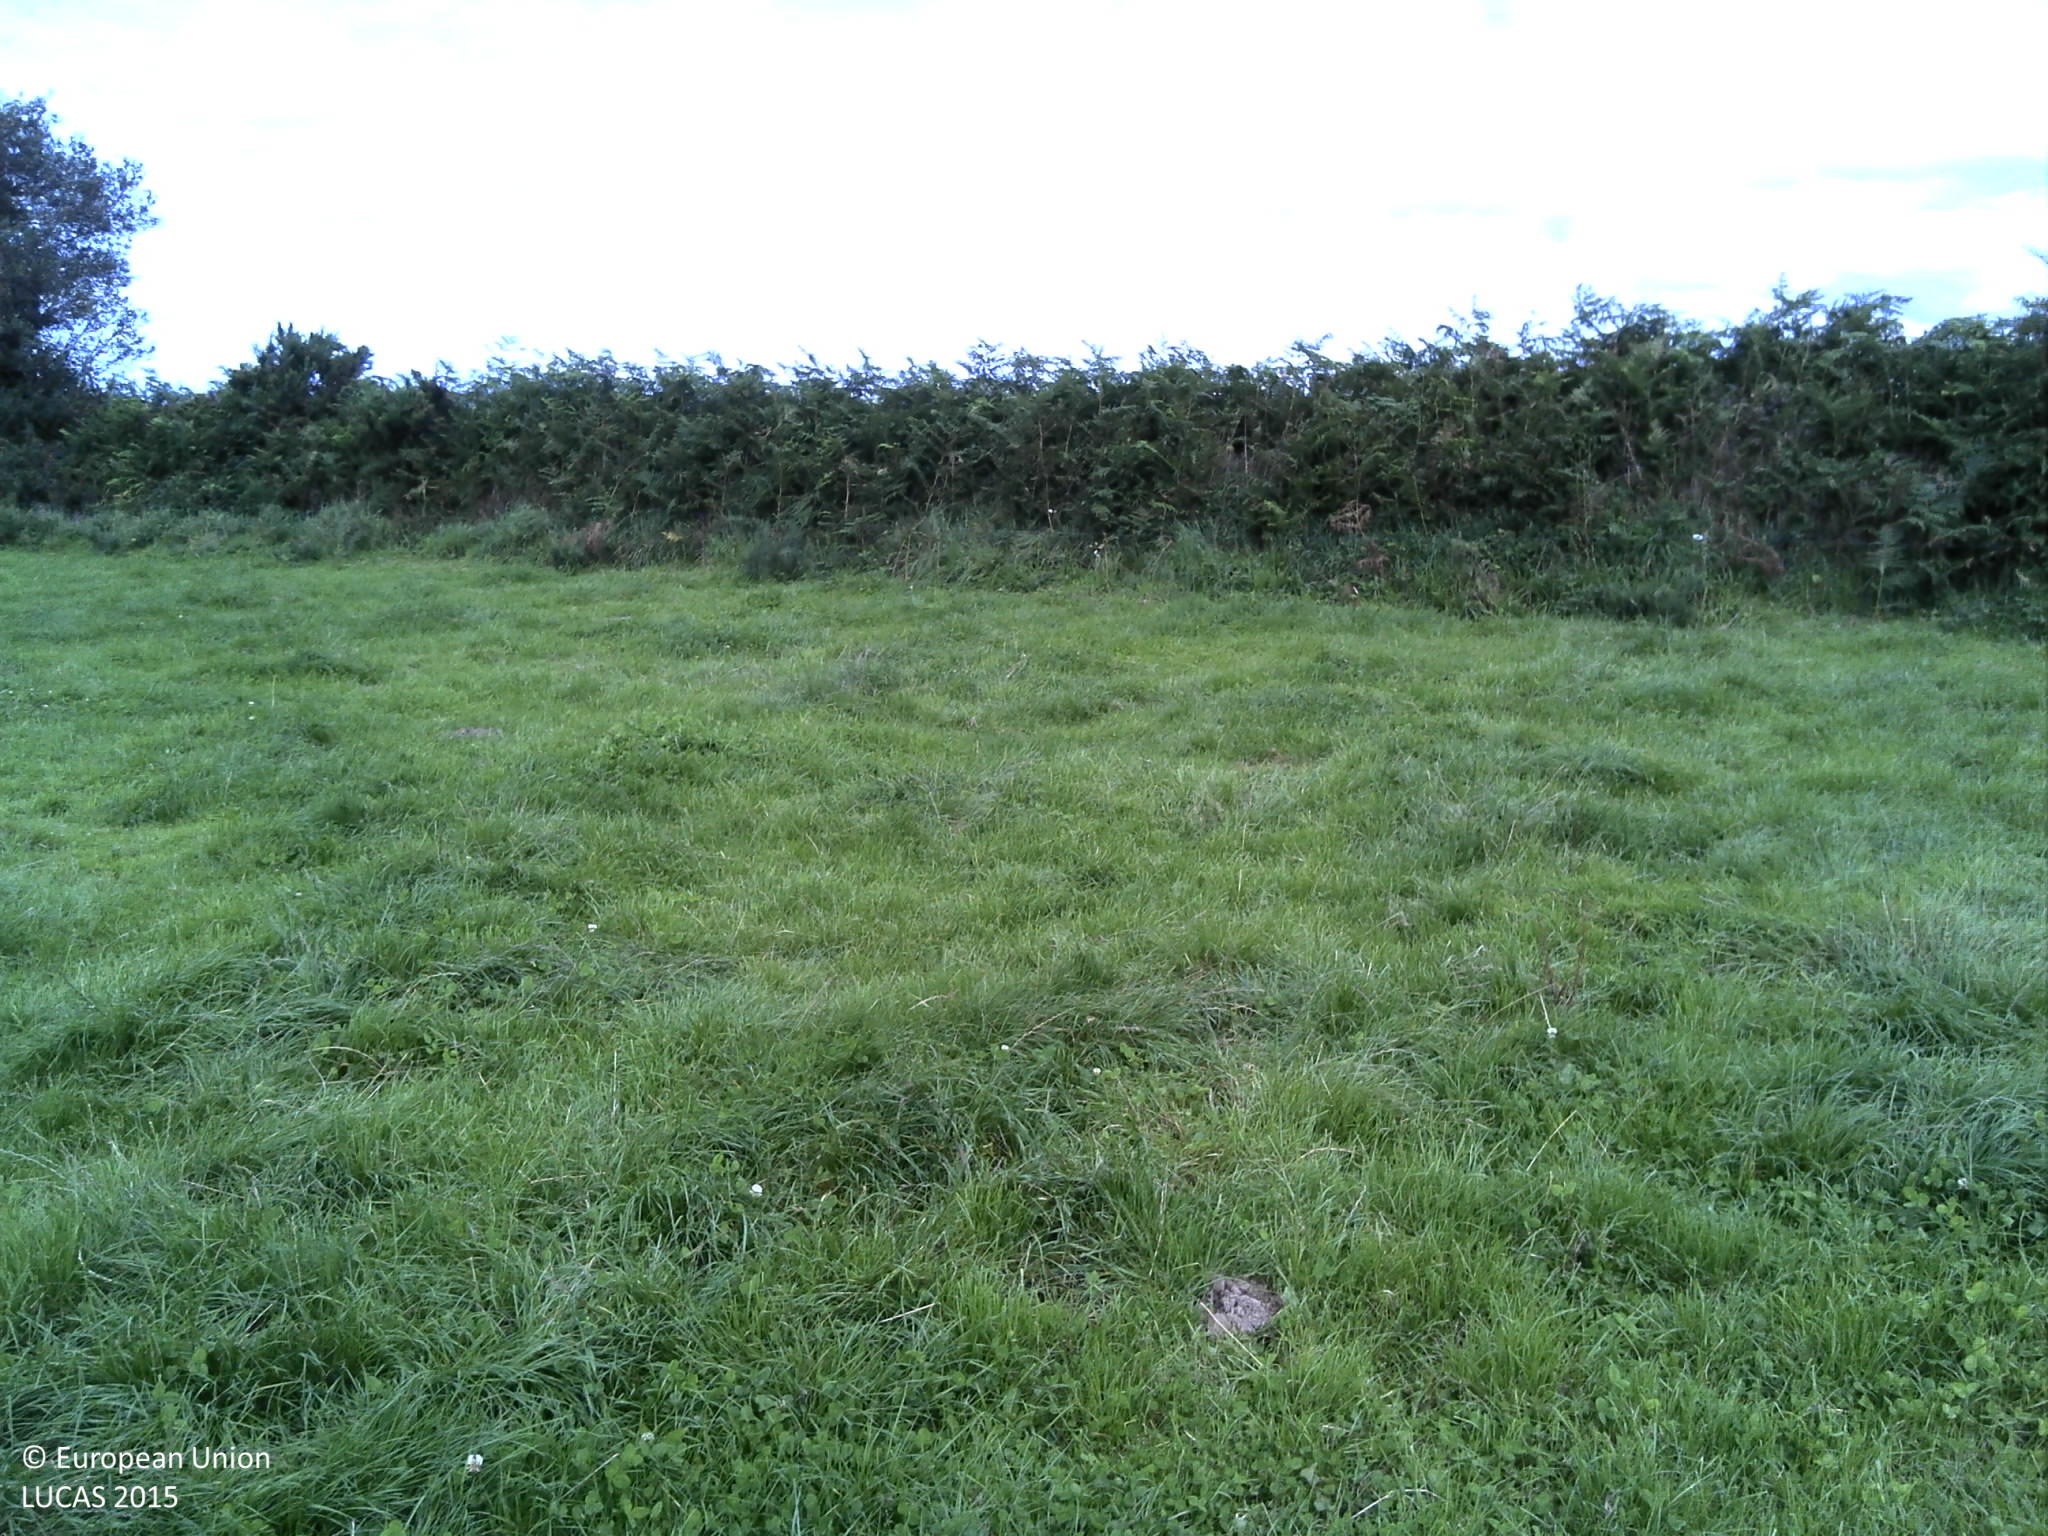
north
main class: Grassland
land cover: Grassland without tree/shrub cover
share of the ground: > 75 %
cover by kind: herbaceous plants 100 %
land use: Agriculture (excluding fallow land and kitchen gardens)
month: September
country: FR
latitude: 48.5205
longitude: -4.2145
